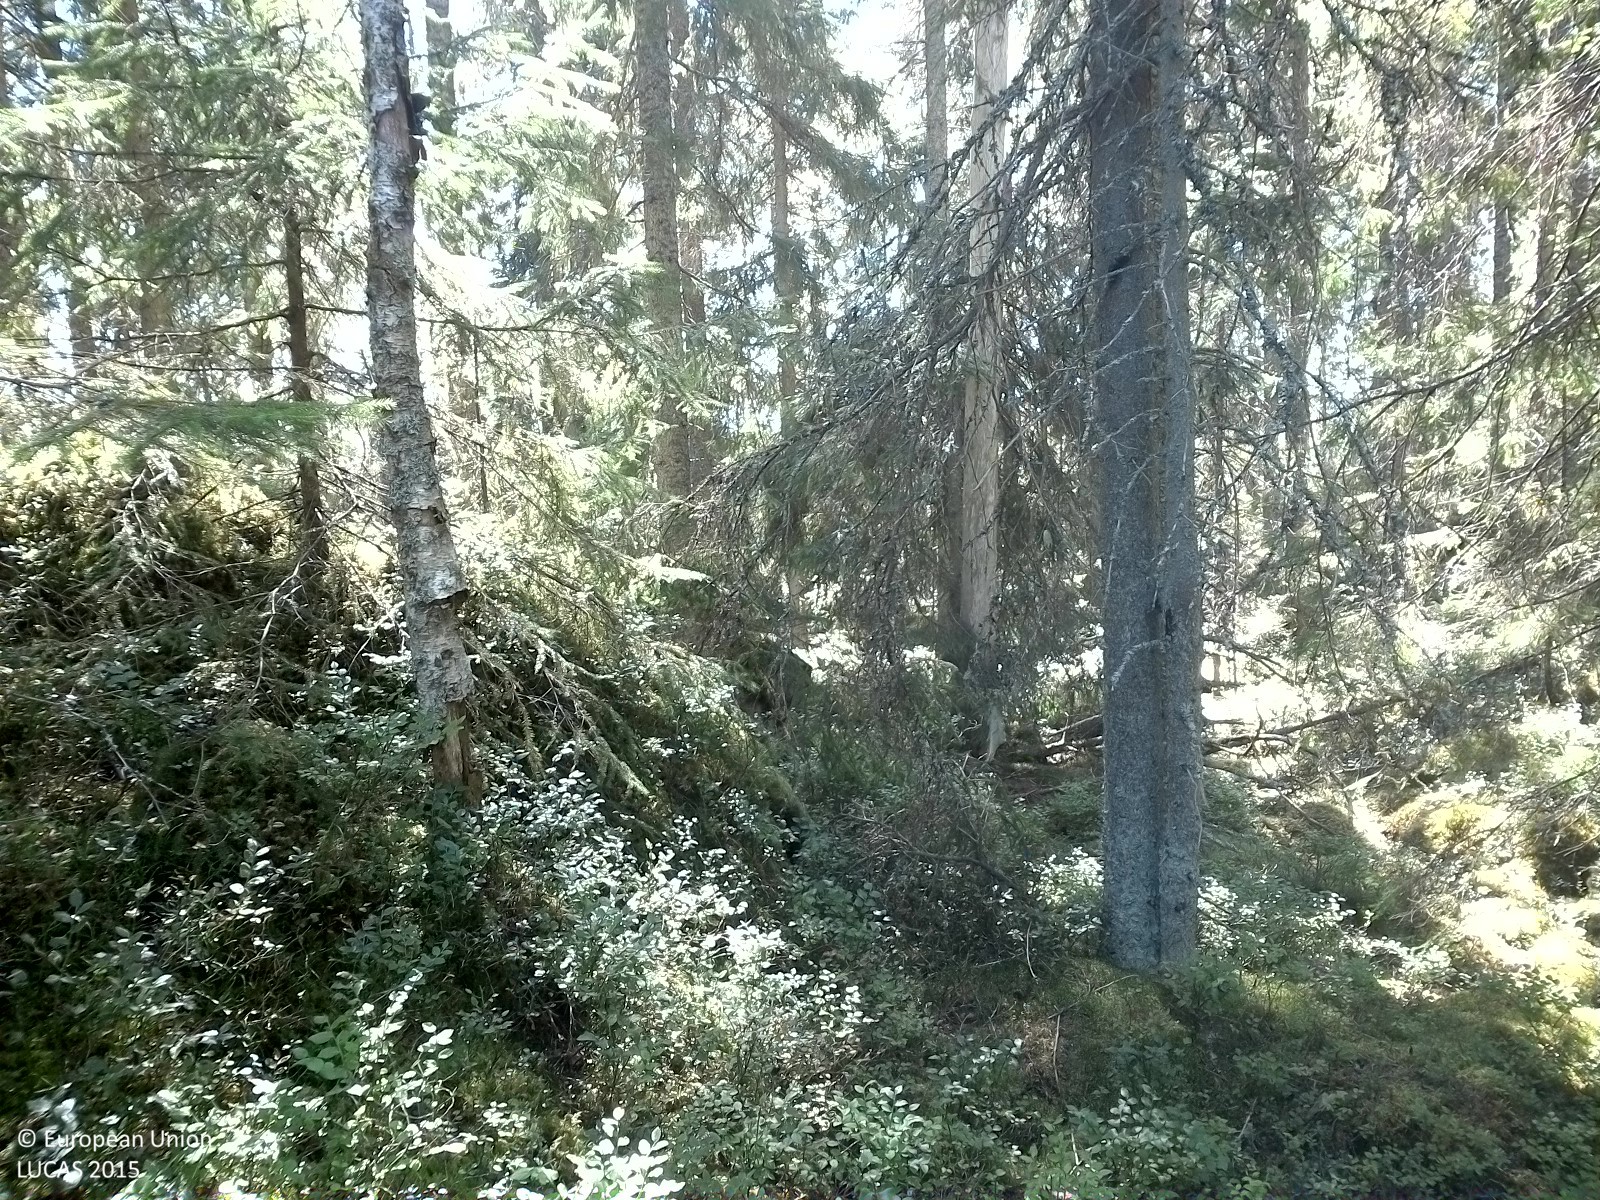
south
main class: Woodland
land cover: Spruce dominated coniferous woodland
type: boreal forest
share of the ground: 50 - 75 %
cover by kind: coniferous forest trees 55 %, herbaceous plants 25 %, lichens and mosses 20 %
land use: Forestry
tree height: > 5 m
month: August
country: SE
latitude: 59.1828
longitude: 14.6994
